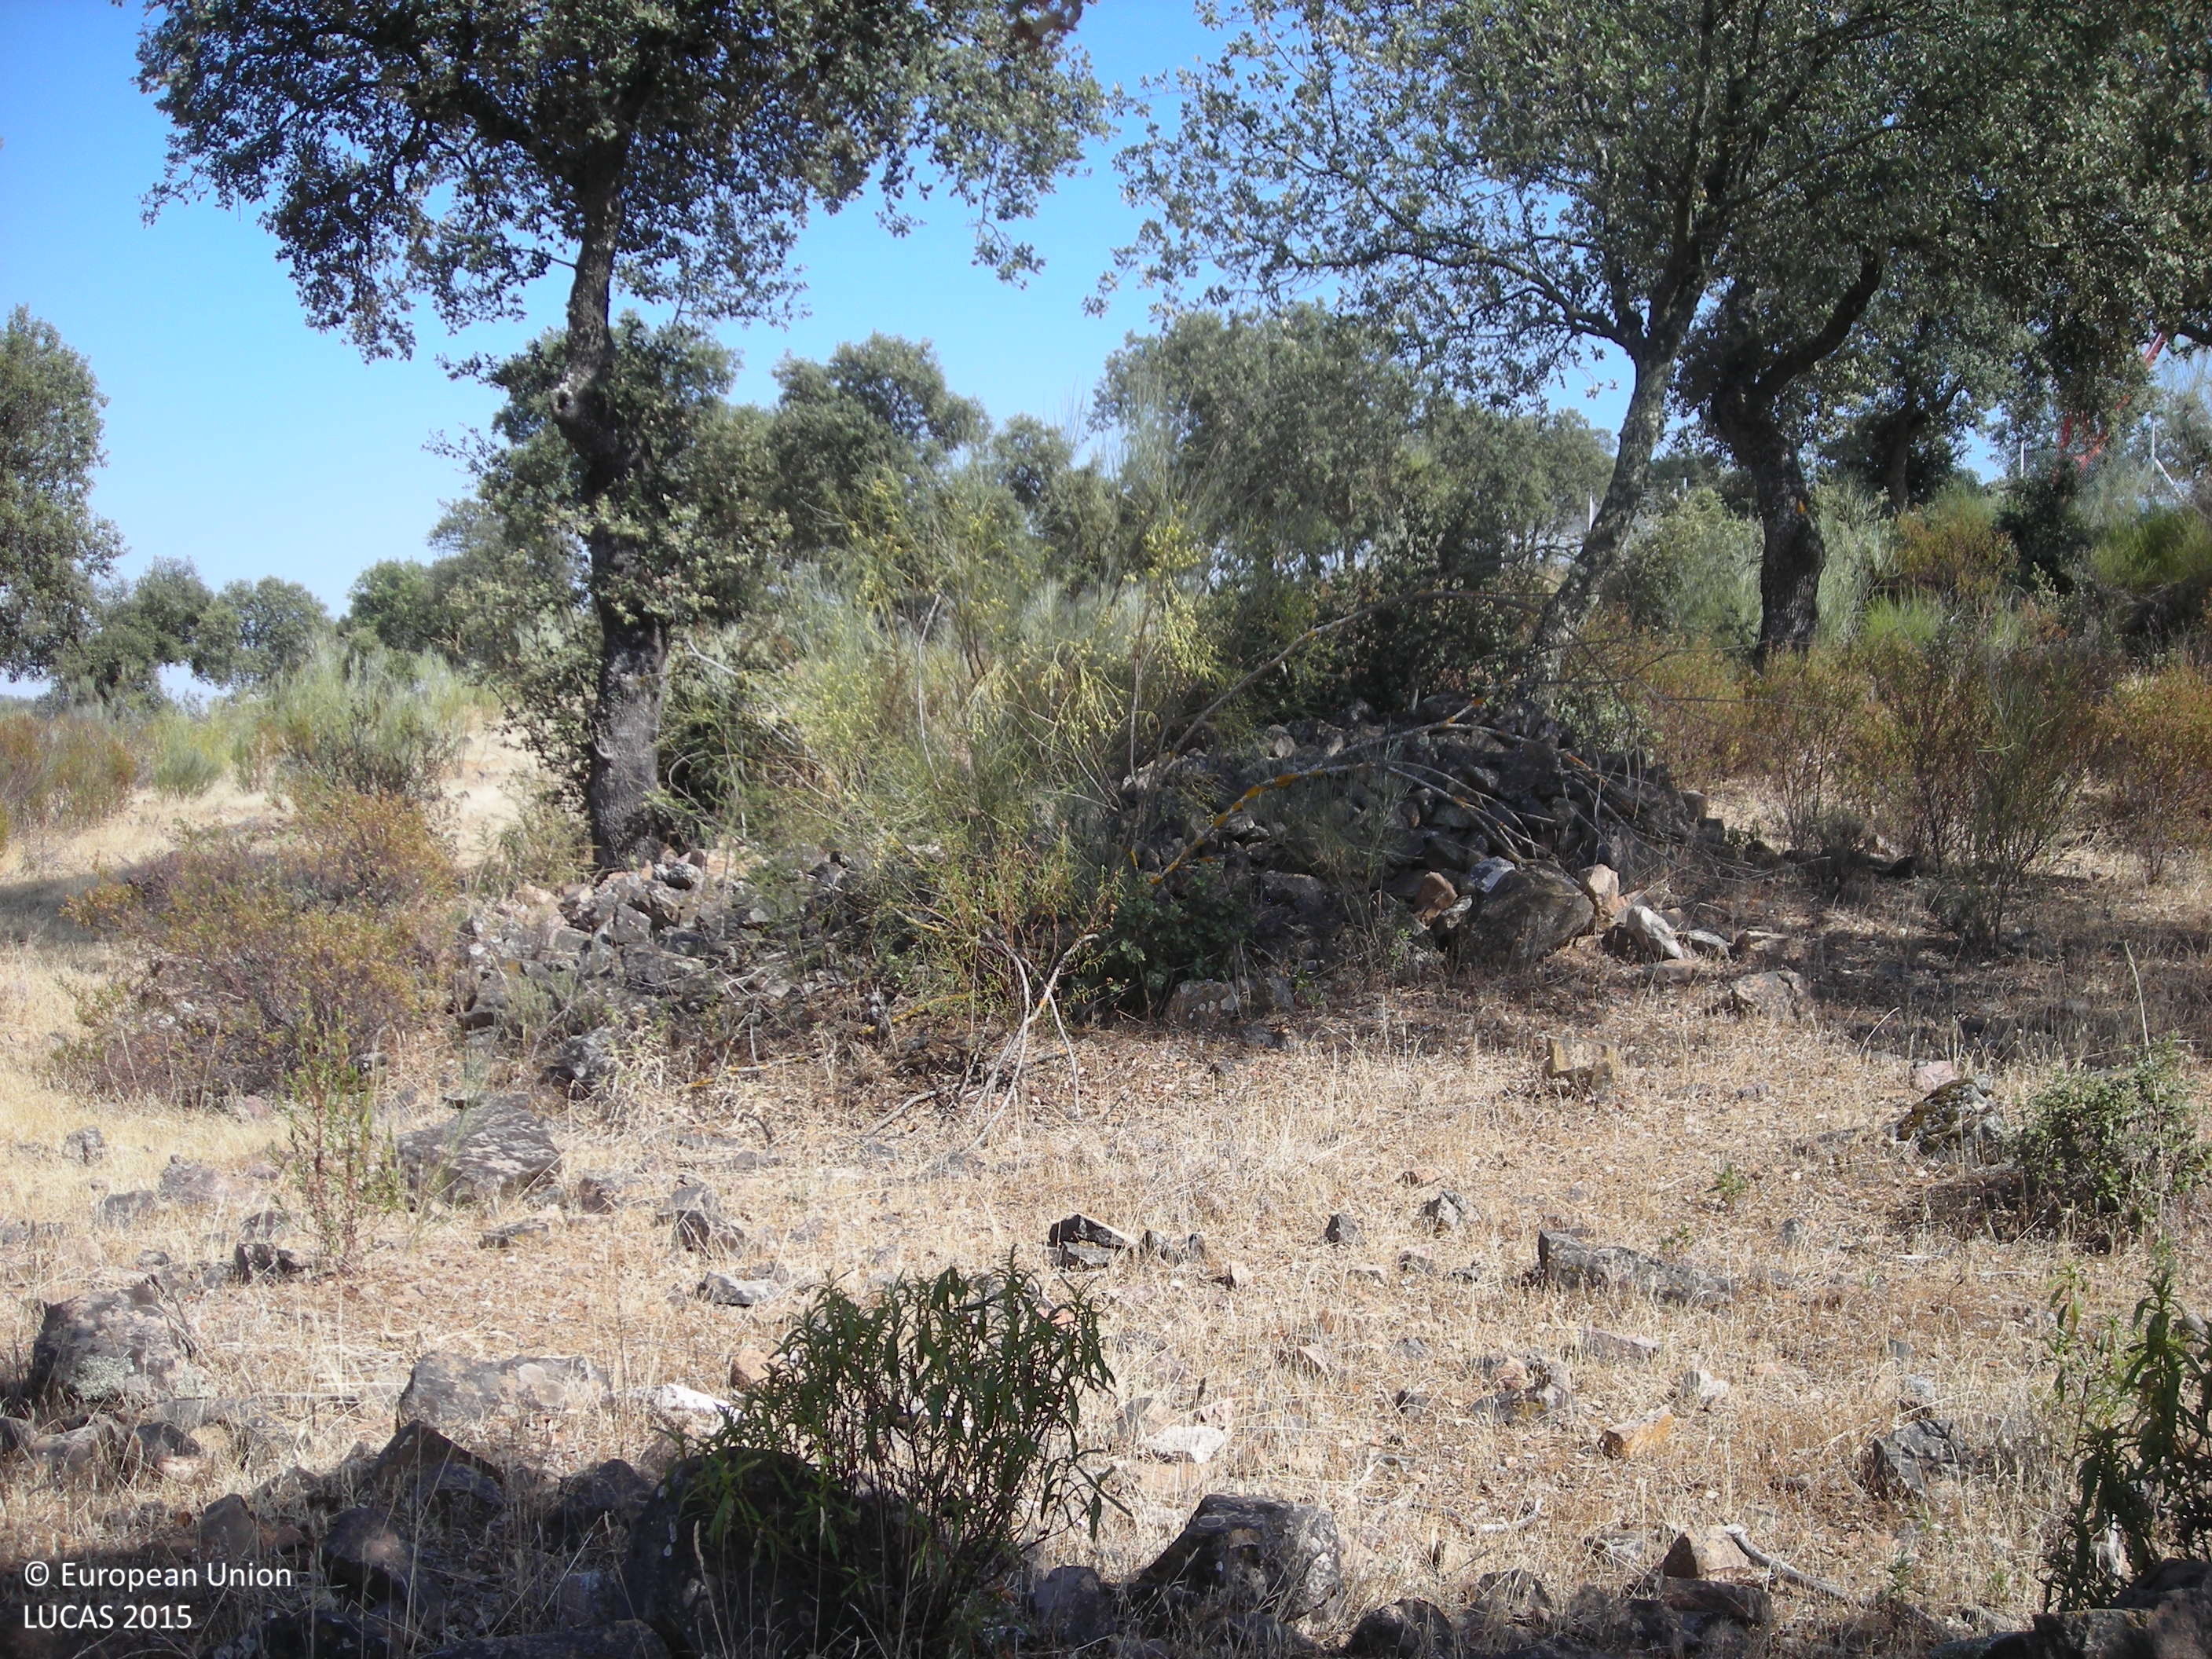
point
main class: Woodland
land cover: Broadleaved woodland
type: broadleaved evergreen forest
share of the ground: > 75 %
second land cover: Grassland without tree/shrub cover
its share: 50 - 75 %
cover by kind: herbaceous plants 60 %, broadleaved forest trees 40 %
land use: Forestry
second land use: Agriculture (excluding fallow land and kitchen gardens)
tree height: > 5 m
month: June
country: ES
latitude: 38.5981
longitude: -5.7603
